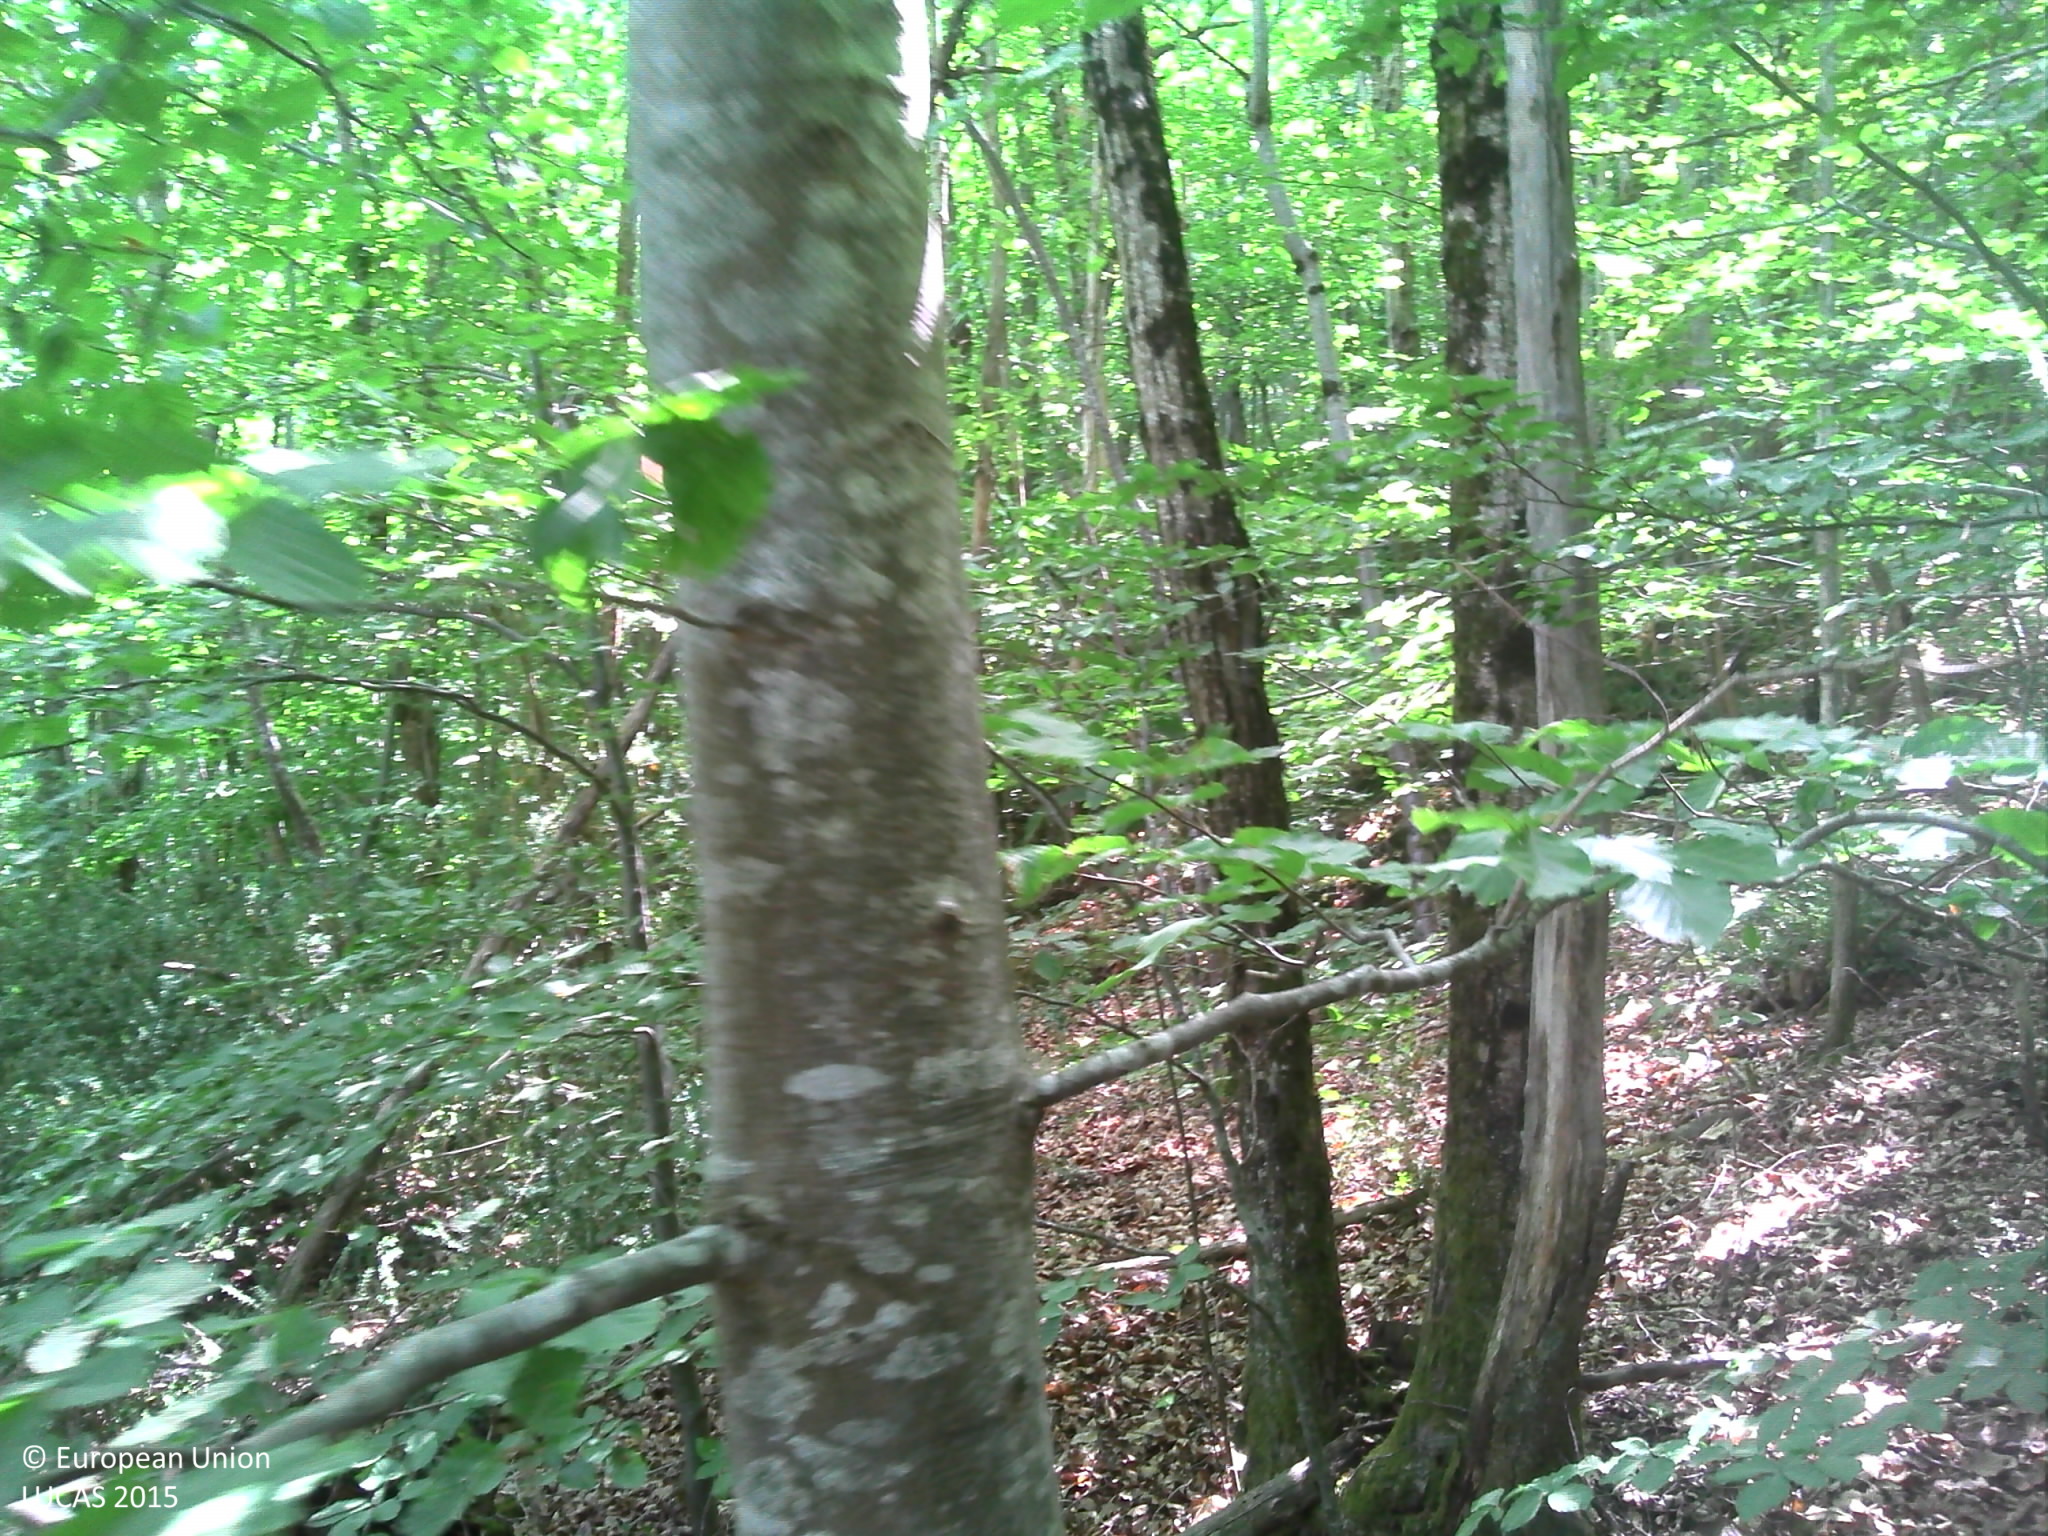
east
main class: Woodland
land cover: Broadleaved woodland
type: beech forest
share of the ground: > 75 %
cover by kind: broadleaved forest trees 85 %, unconsolidated bare surface 10 %, coniferous forest trees 5 %
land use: Forestry
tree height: > 5 m
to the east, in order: Broadleaved woodland; Shrubland with sparse tree cover; Rocks and stones
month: July
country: FR
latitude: 44.2228
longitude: 3.5597
